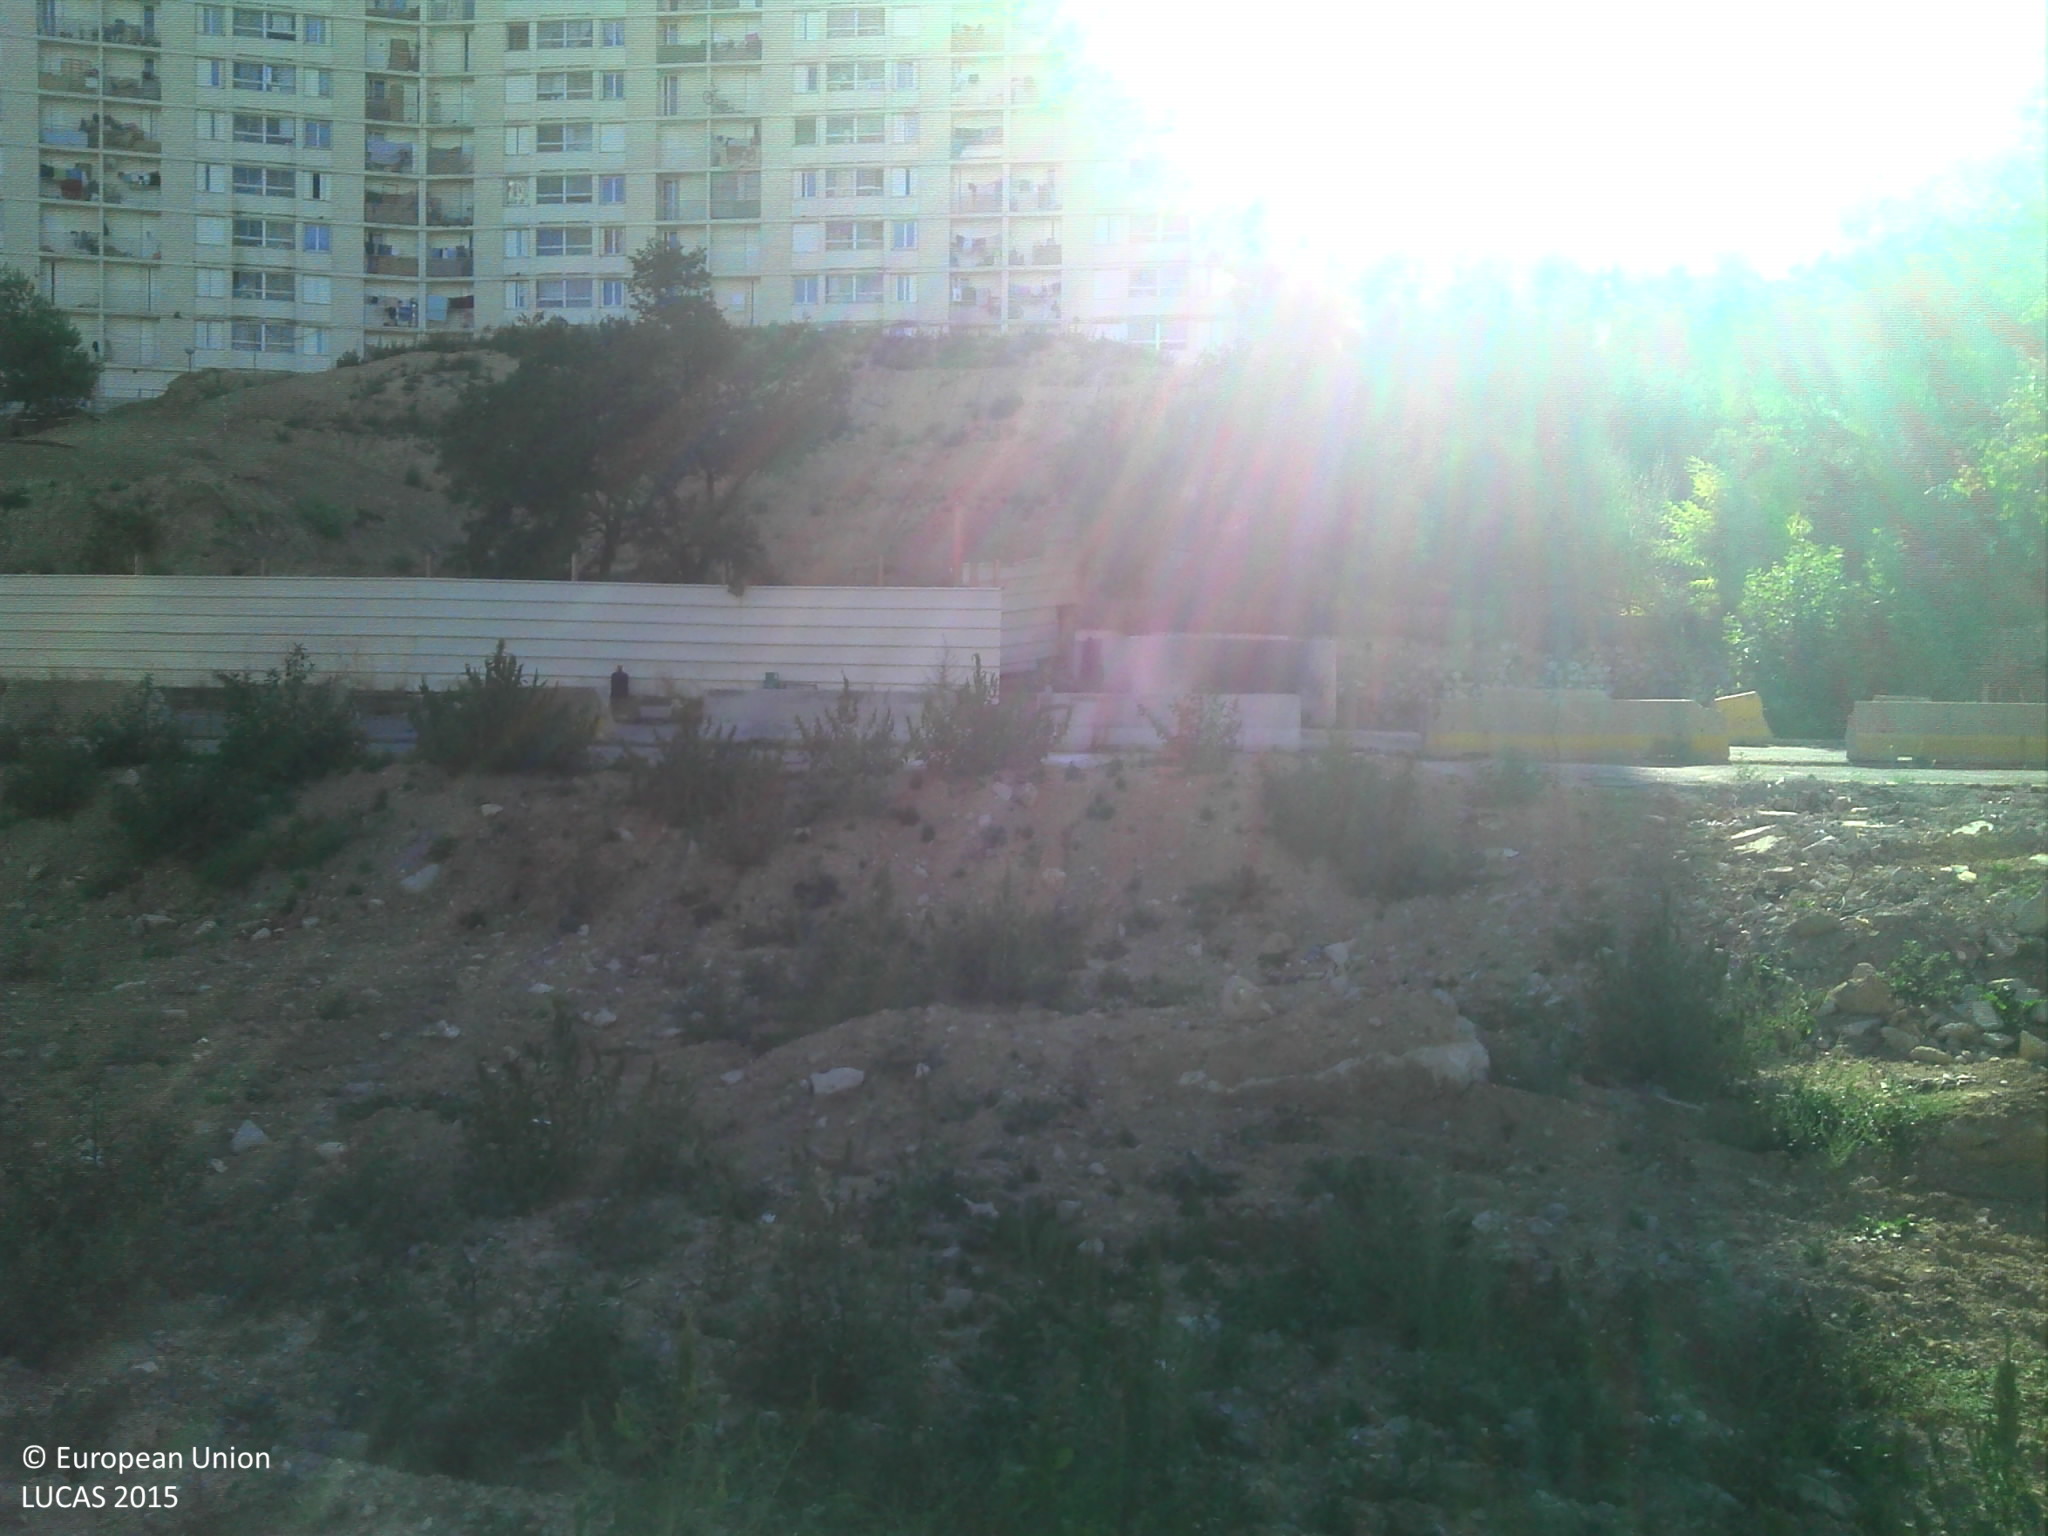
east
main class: Grassland
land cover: Grassland with sparse tree/shrub cover
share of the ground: 50 - 75 %
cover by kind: consolidated bare surface 40 %, unconsolidated bare surface 30 %, herbaceous plants 20 %, broadleaved forest trees 5 %, shrubs 5 %
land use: Abandoned areas
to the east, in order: Grassland with sparse tree/shrub cover; Artificial constructions in urban areas
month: August
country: FR
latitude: 43.3275
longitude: 5.4103
